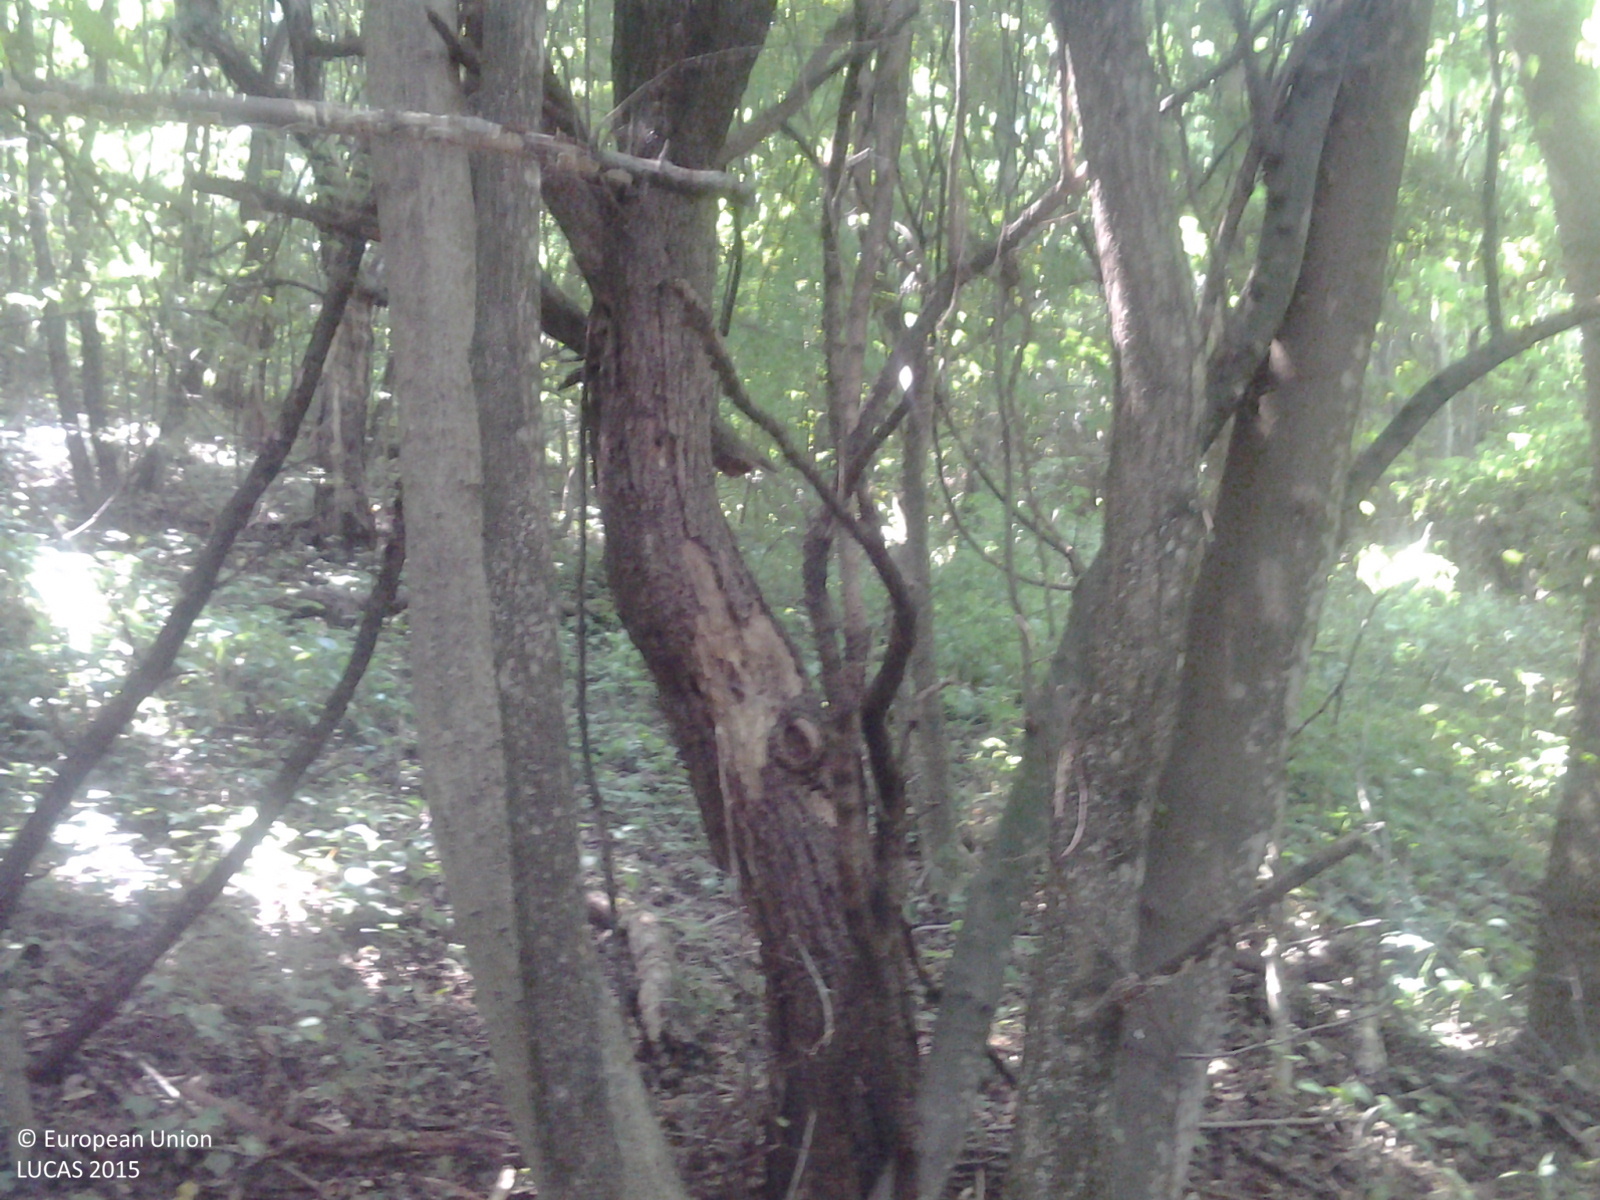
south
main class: Woodland
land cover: Broadleaved woodland
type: beech forest
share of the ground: > 75 %
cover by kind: broadleaved forest trees 100 %
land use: Forestry
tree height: > 5 m
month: August
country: HU
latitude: 46.5679
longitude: 17.0877
